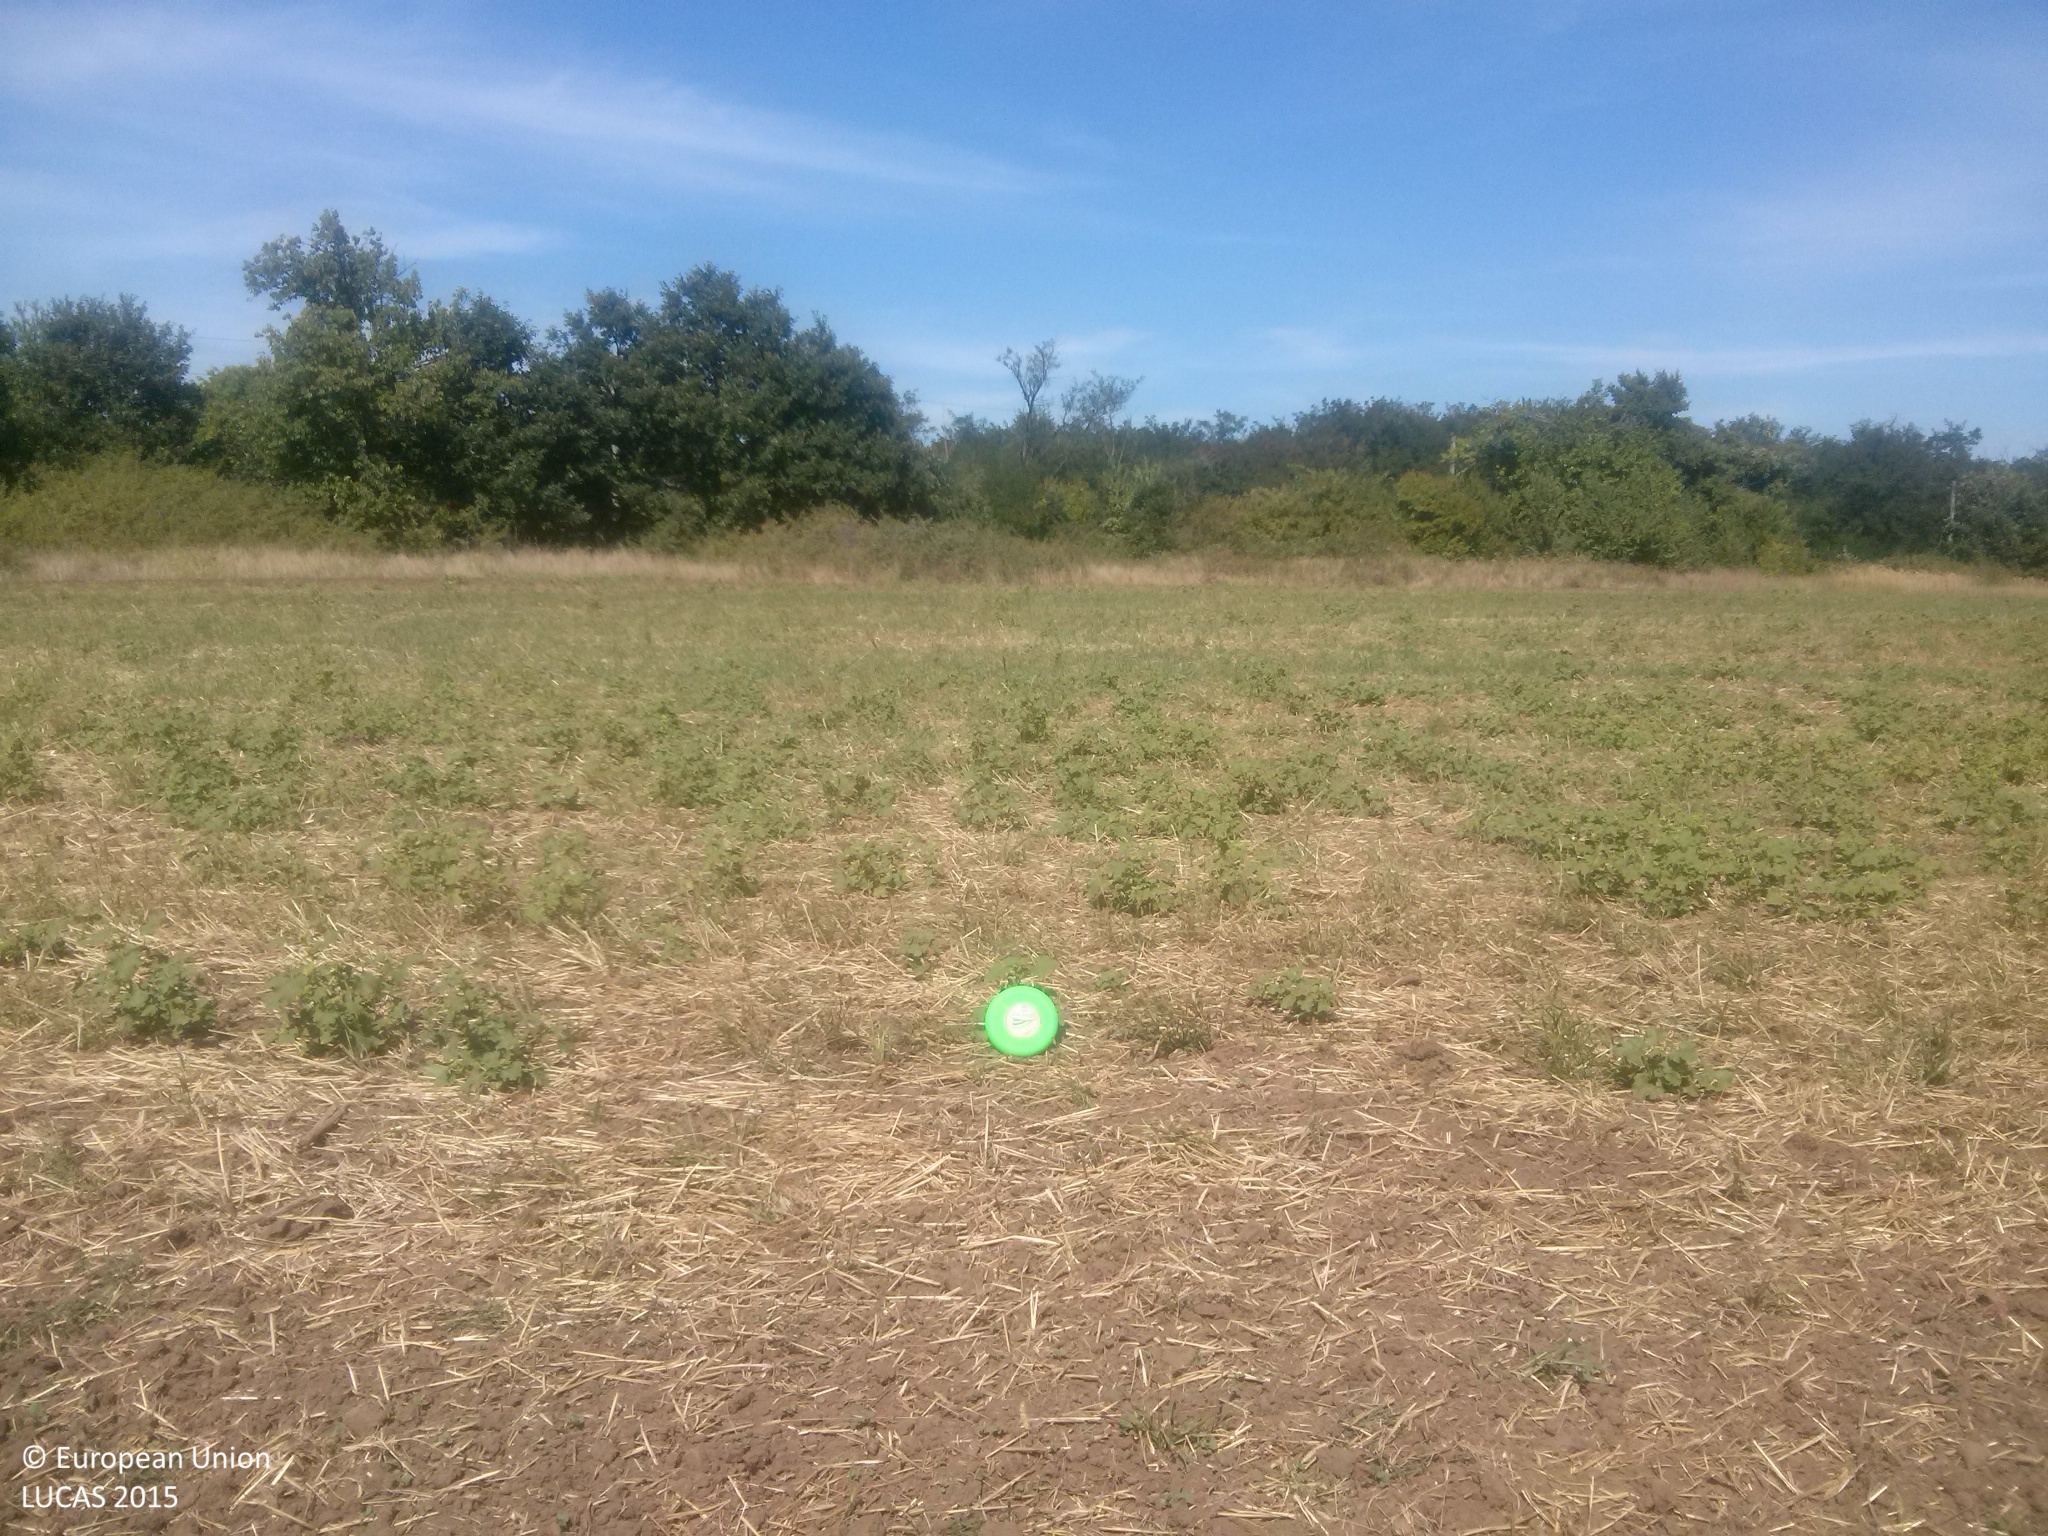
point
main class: Cropland
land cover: Common wheat
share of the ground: 10 - 25 %
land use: Agriculture (excluding fallow land and kitchen gardens)
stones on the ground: < 10 %
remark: Tilled/Sowed
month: September
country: BG
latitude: 43.6914
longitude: 26.3180
